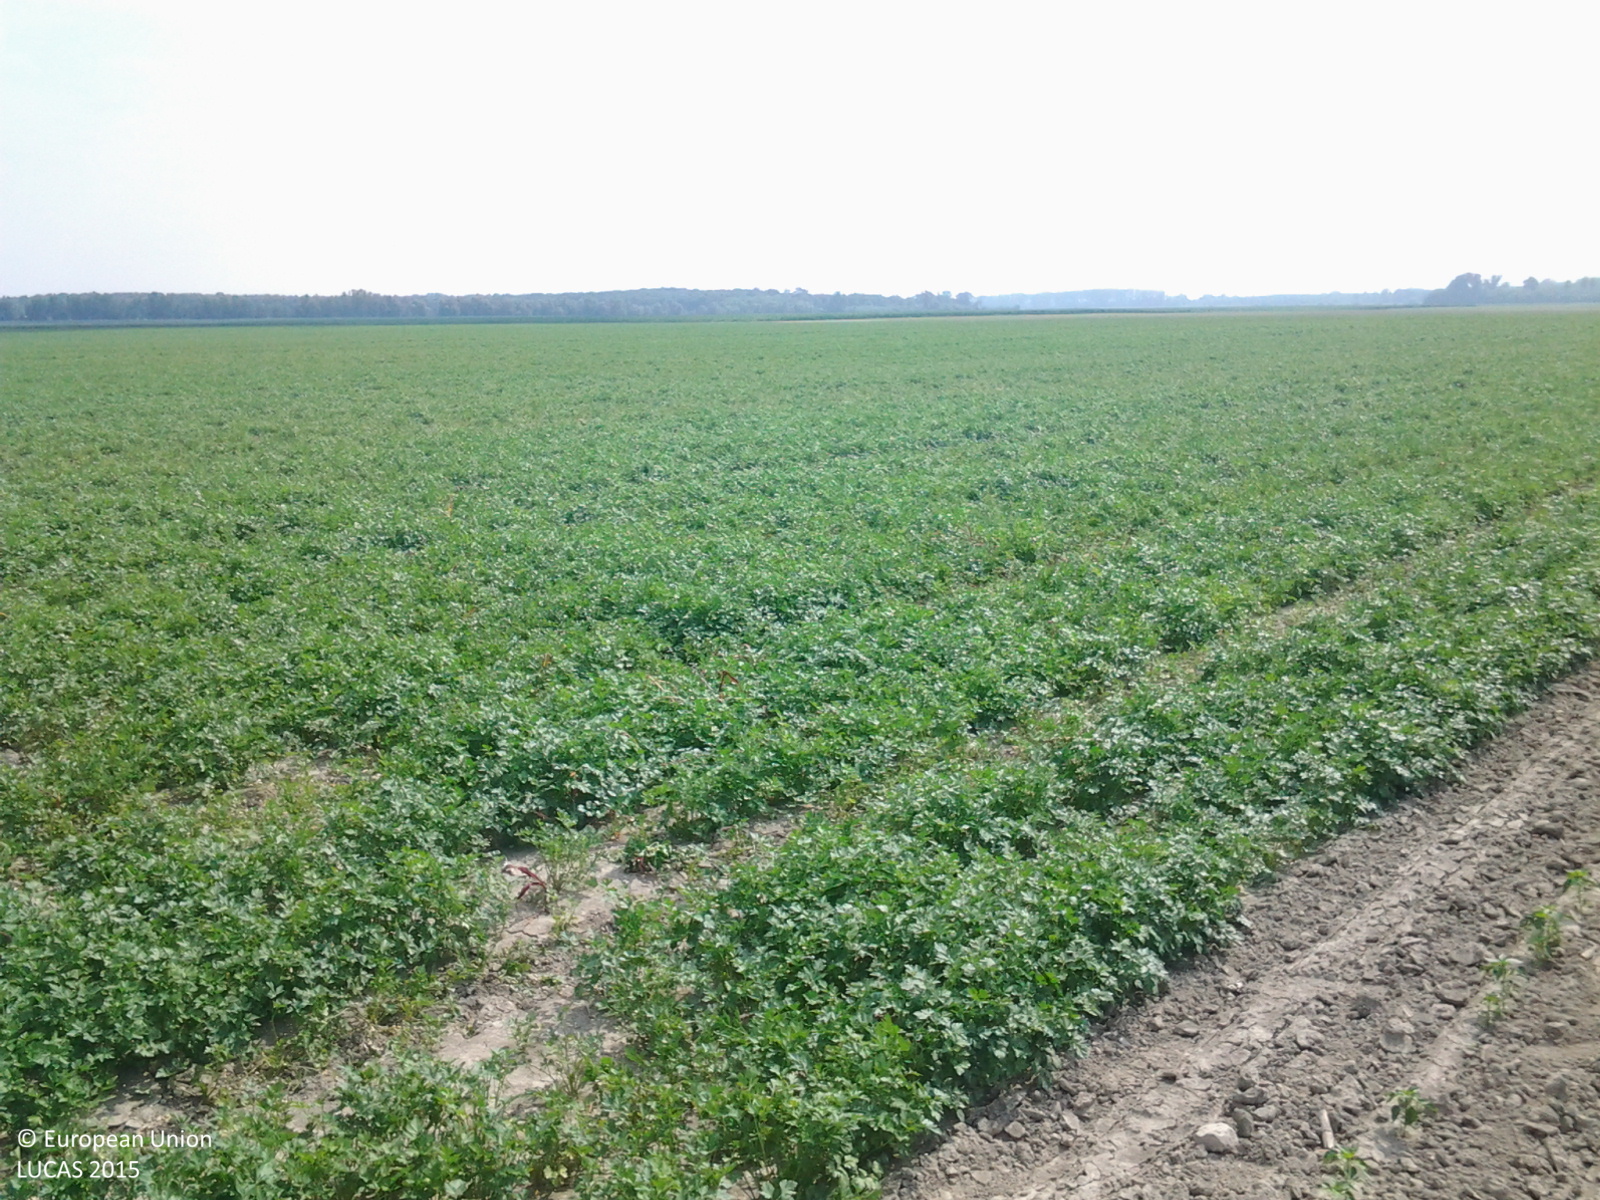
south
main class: Cropland
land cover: Other fresh vegetables
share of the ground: < 10 %
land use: Agriculture (excluding fallow land and kitchen gardens)
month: June
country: HU
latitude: 46.3945
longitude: 18.9212
